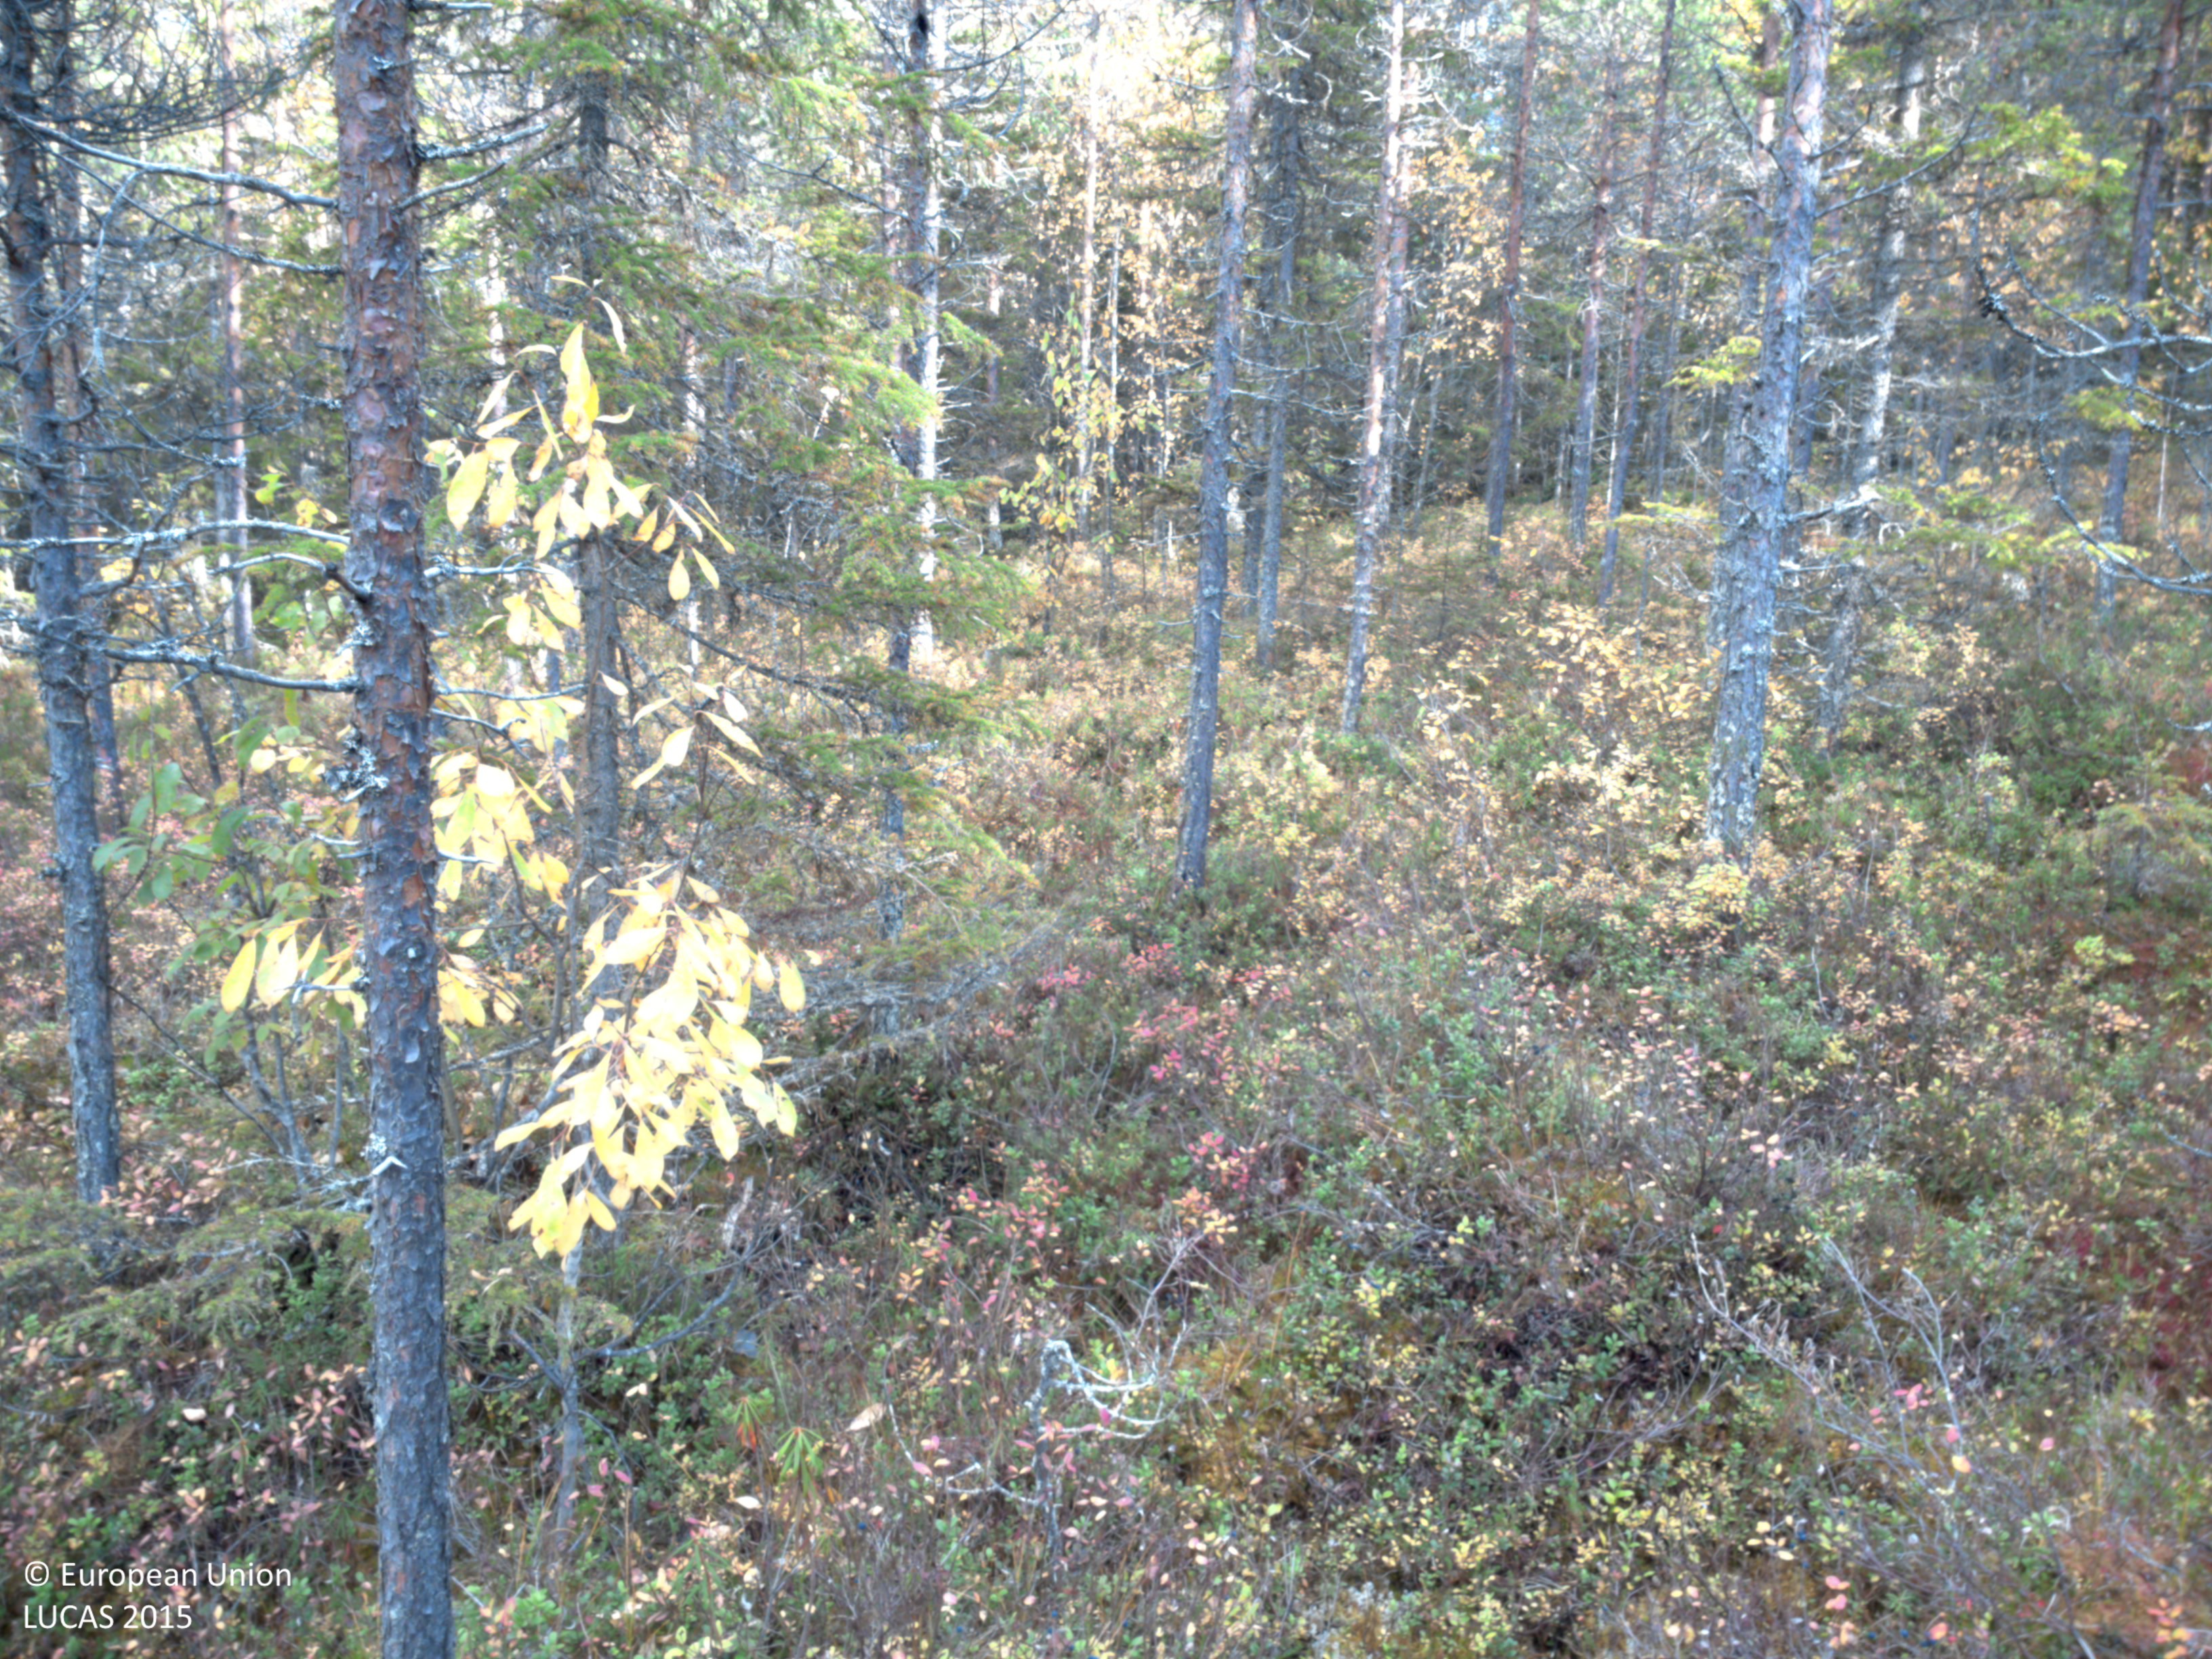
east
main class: Woodland
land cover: Pine dominated coniferous woodland
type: boreal forest
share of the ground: > 75 %
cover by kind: coniferous forest trees 75 %, shrubs 20 %, lichens and mosses 5 %
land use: Forestry
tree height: > 5 m
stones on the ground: 10 - 25 %
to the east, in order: Pine dominated coniferous woodland; Pine dominated mixed woodland; Spruce dominated mixed woodland; Pine dominated mixed woodland; Spruce dominated mixed woodland; Ditches and canals; Tracks; Other mixed woodland; Pine dominated coniferous woodland
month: September
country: SE
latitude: 64.7883
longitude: 19.1624
